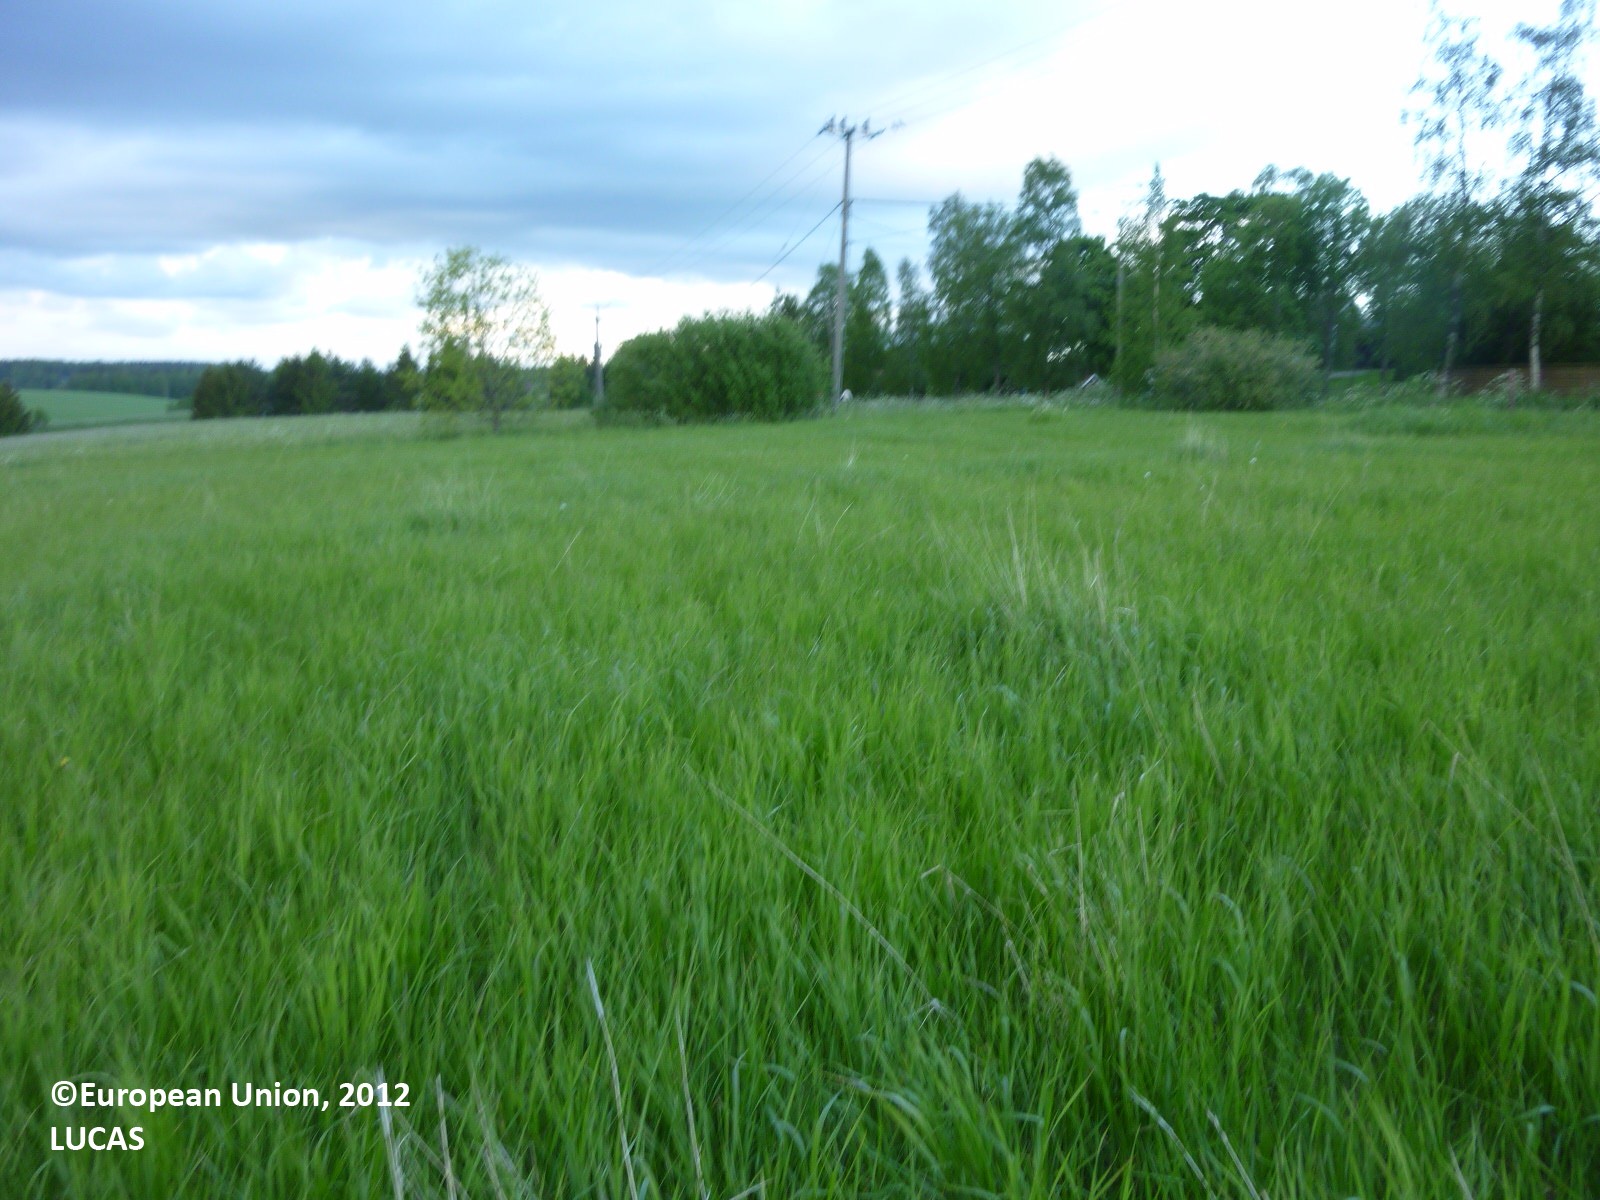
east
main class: Grassland
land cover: Grassland without tree/shrub cover
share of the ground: > 75 %
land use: Agriculture (excluding fallow land and kitchen gardens)
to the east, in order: Grassland without tree/shrub cover; Ditches and canals; Grassland without tree/shrub cover; Ditches and canals; Grassland without tree/shrub cover; Ditches and canals; Grassland without tree/shrub cover; Ditches and canals; Grassland without tree/shrub cover; Ditches and canals; Grassland without tree/shrub cover; Ditches and canals; Grassland without tree/shrub cover; Ditches and canals; Grassland without tree/shrub cover; Grass margins; Tracks; Grass margins; Spruce dominated coniferous woodland; Grassland without tree/shrub cover; Rivers and streams; Grassland without tree/shrub cover; Ditches and canals; Grass margins; Rye
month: June
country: FI
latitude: 60.4900
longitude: 22.3900
